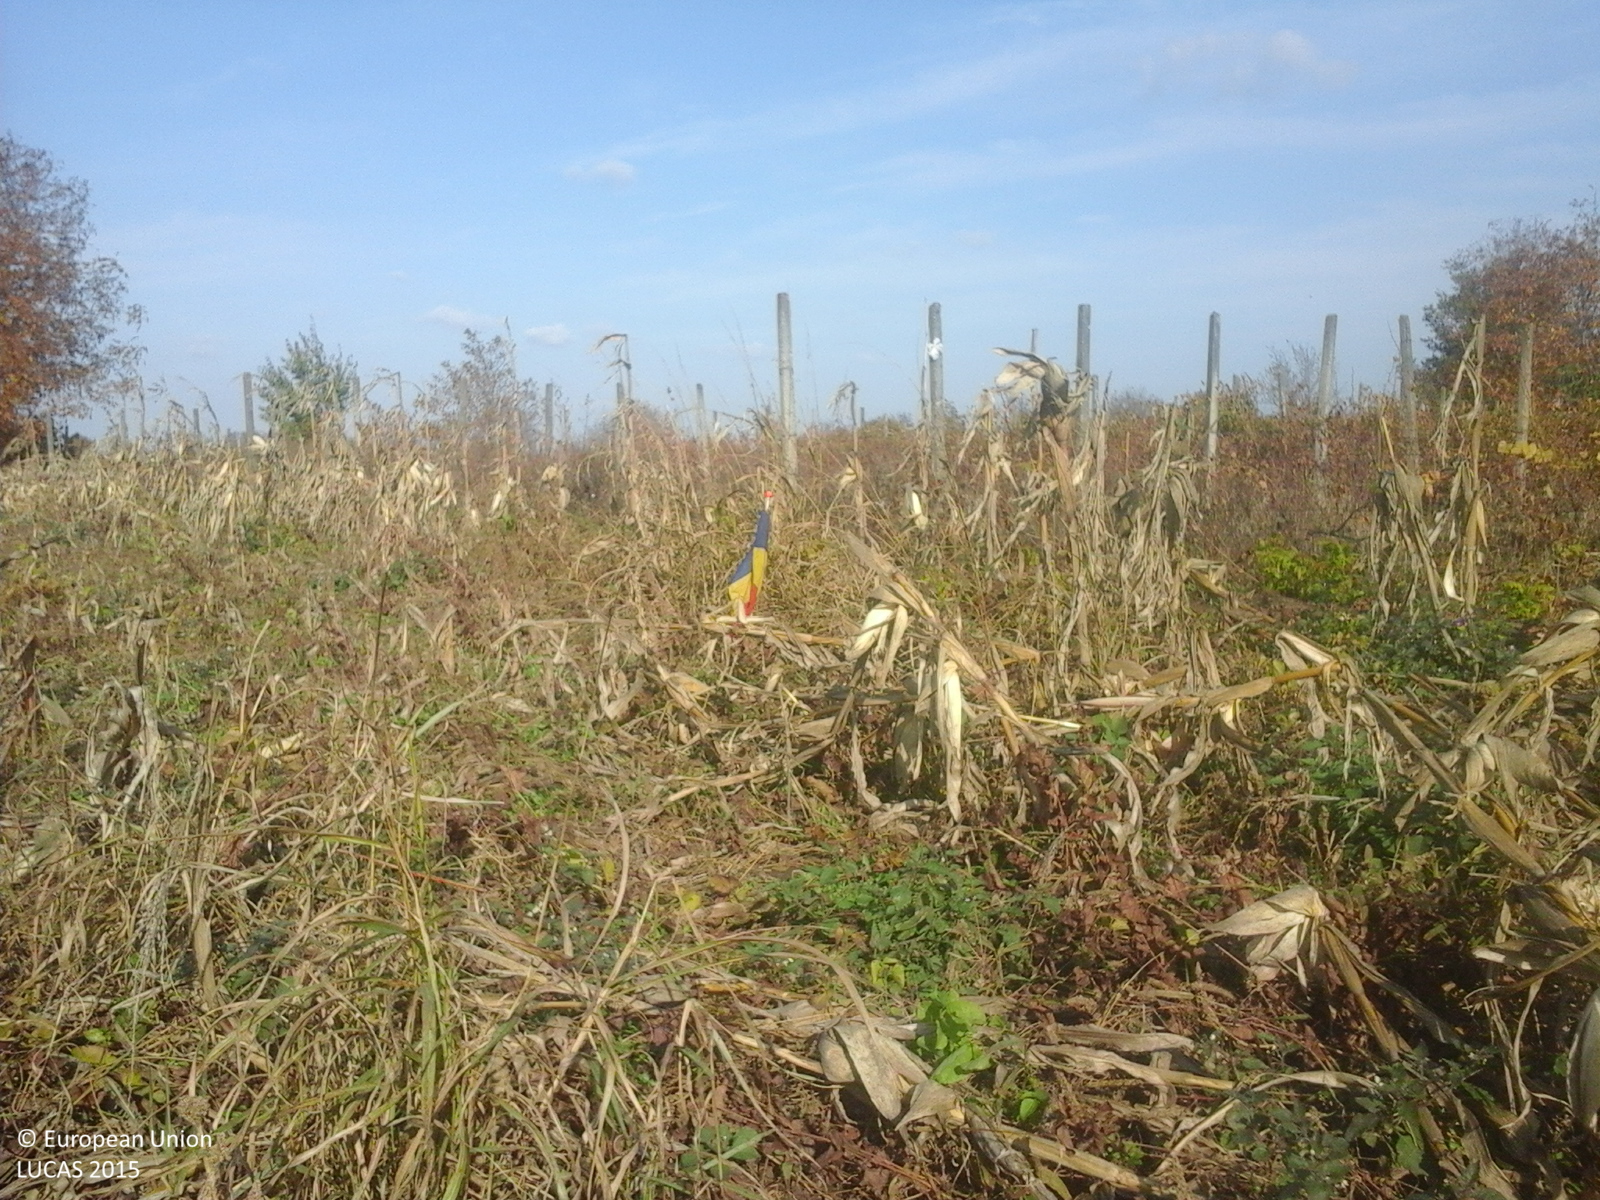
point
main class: Cropland
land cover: Maize
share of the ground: > 75 %
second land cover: Spontaneously vegetated surfaces
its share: 25 - 50 %
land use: Agriculture (excluding fallow land and kitchen gardens)
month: October
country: RO
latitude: 45.3221
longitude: 27.2524
